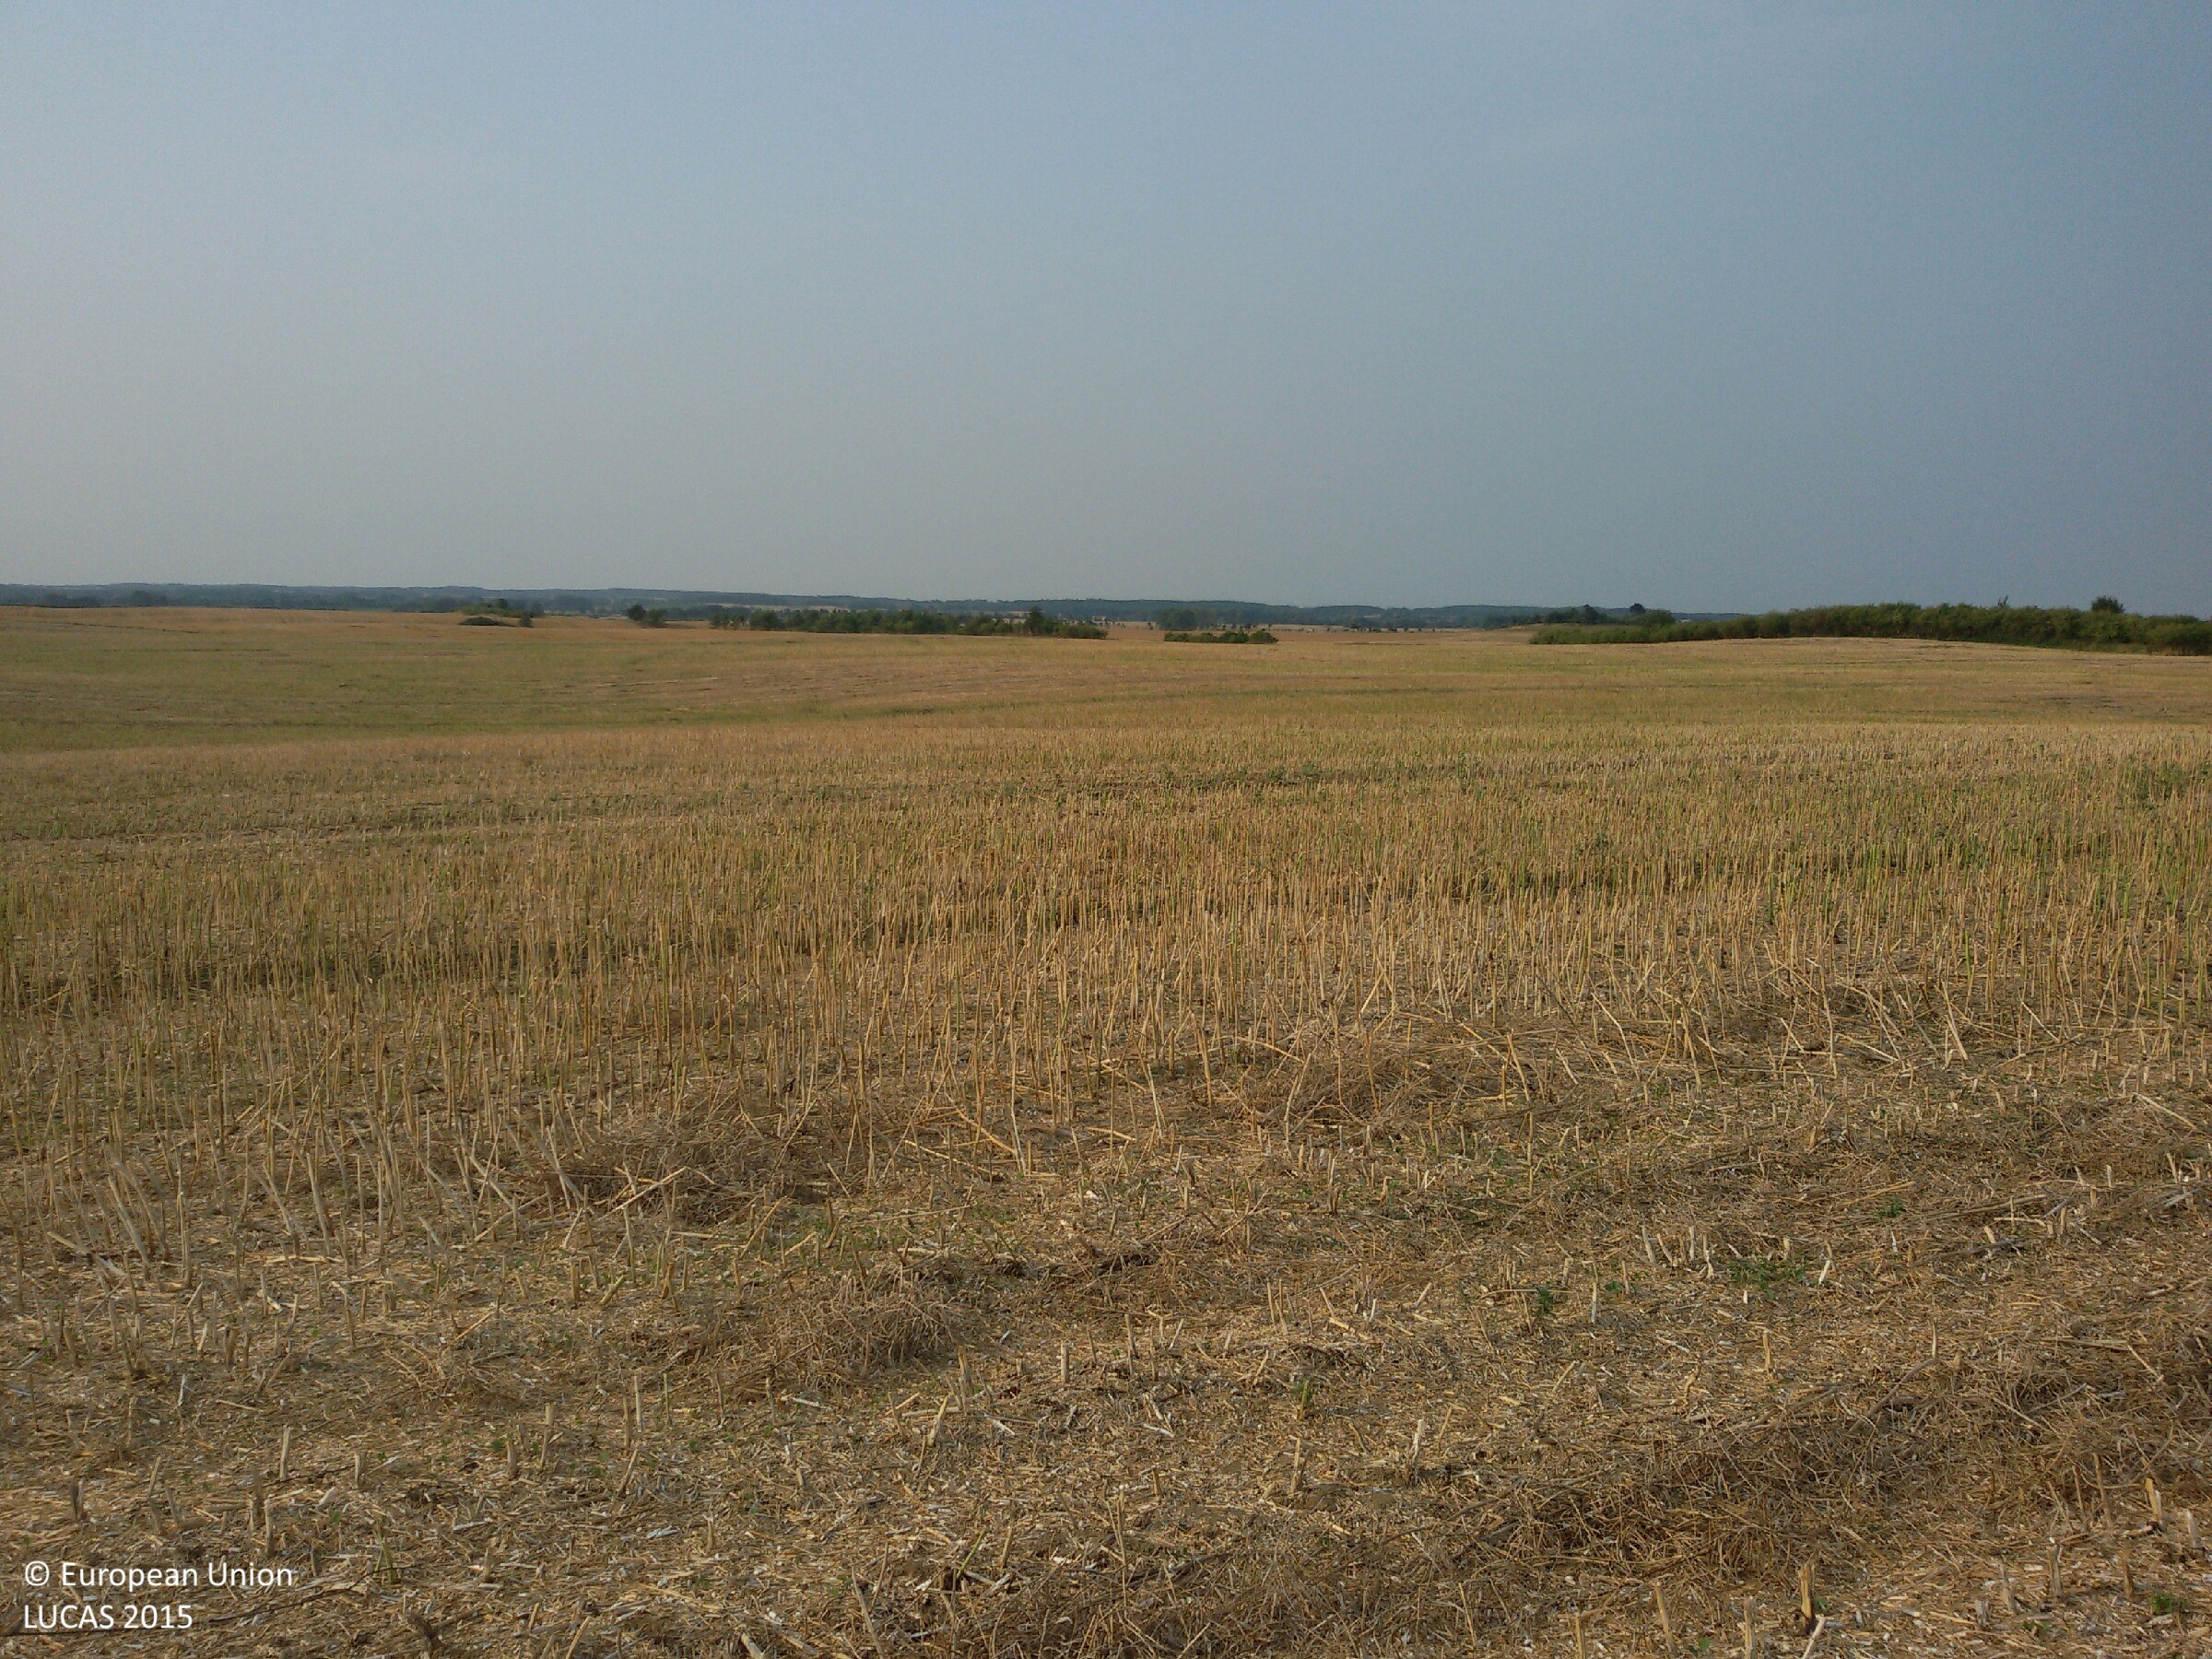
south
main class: Cropland
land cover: Rape and turnip rape
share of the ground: 50 - 75 %
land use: Agriculture (excluding fallow land and kitchen gardens)
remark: Harvested field
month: August
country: PL
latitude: 52.9915
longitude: 14.5751
